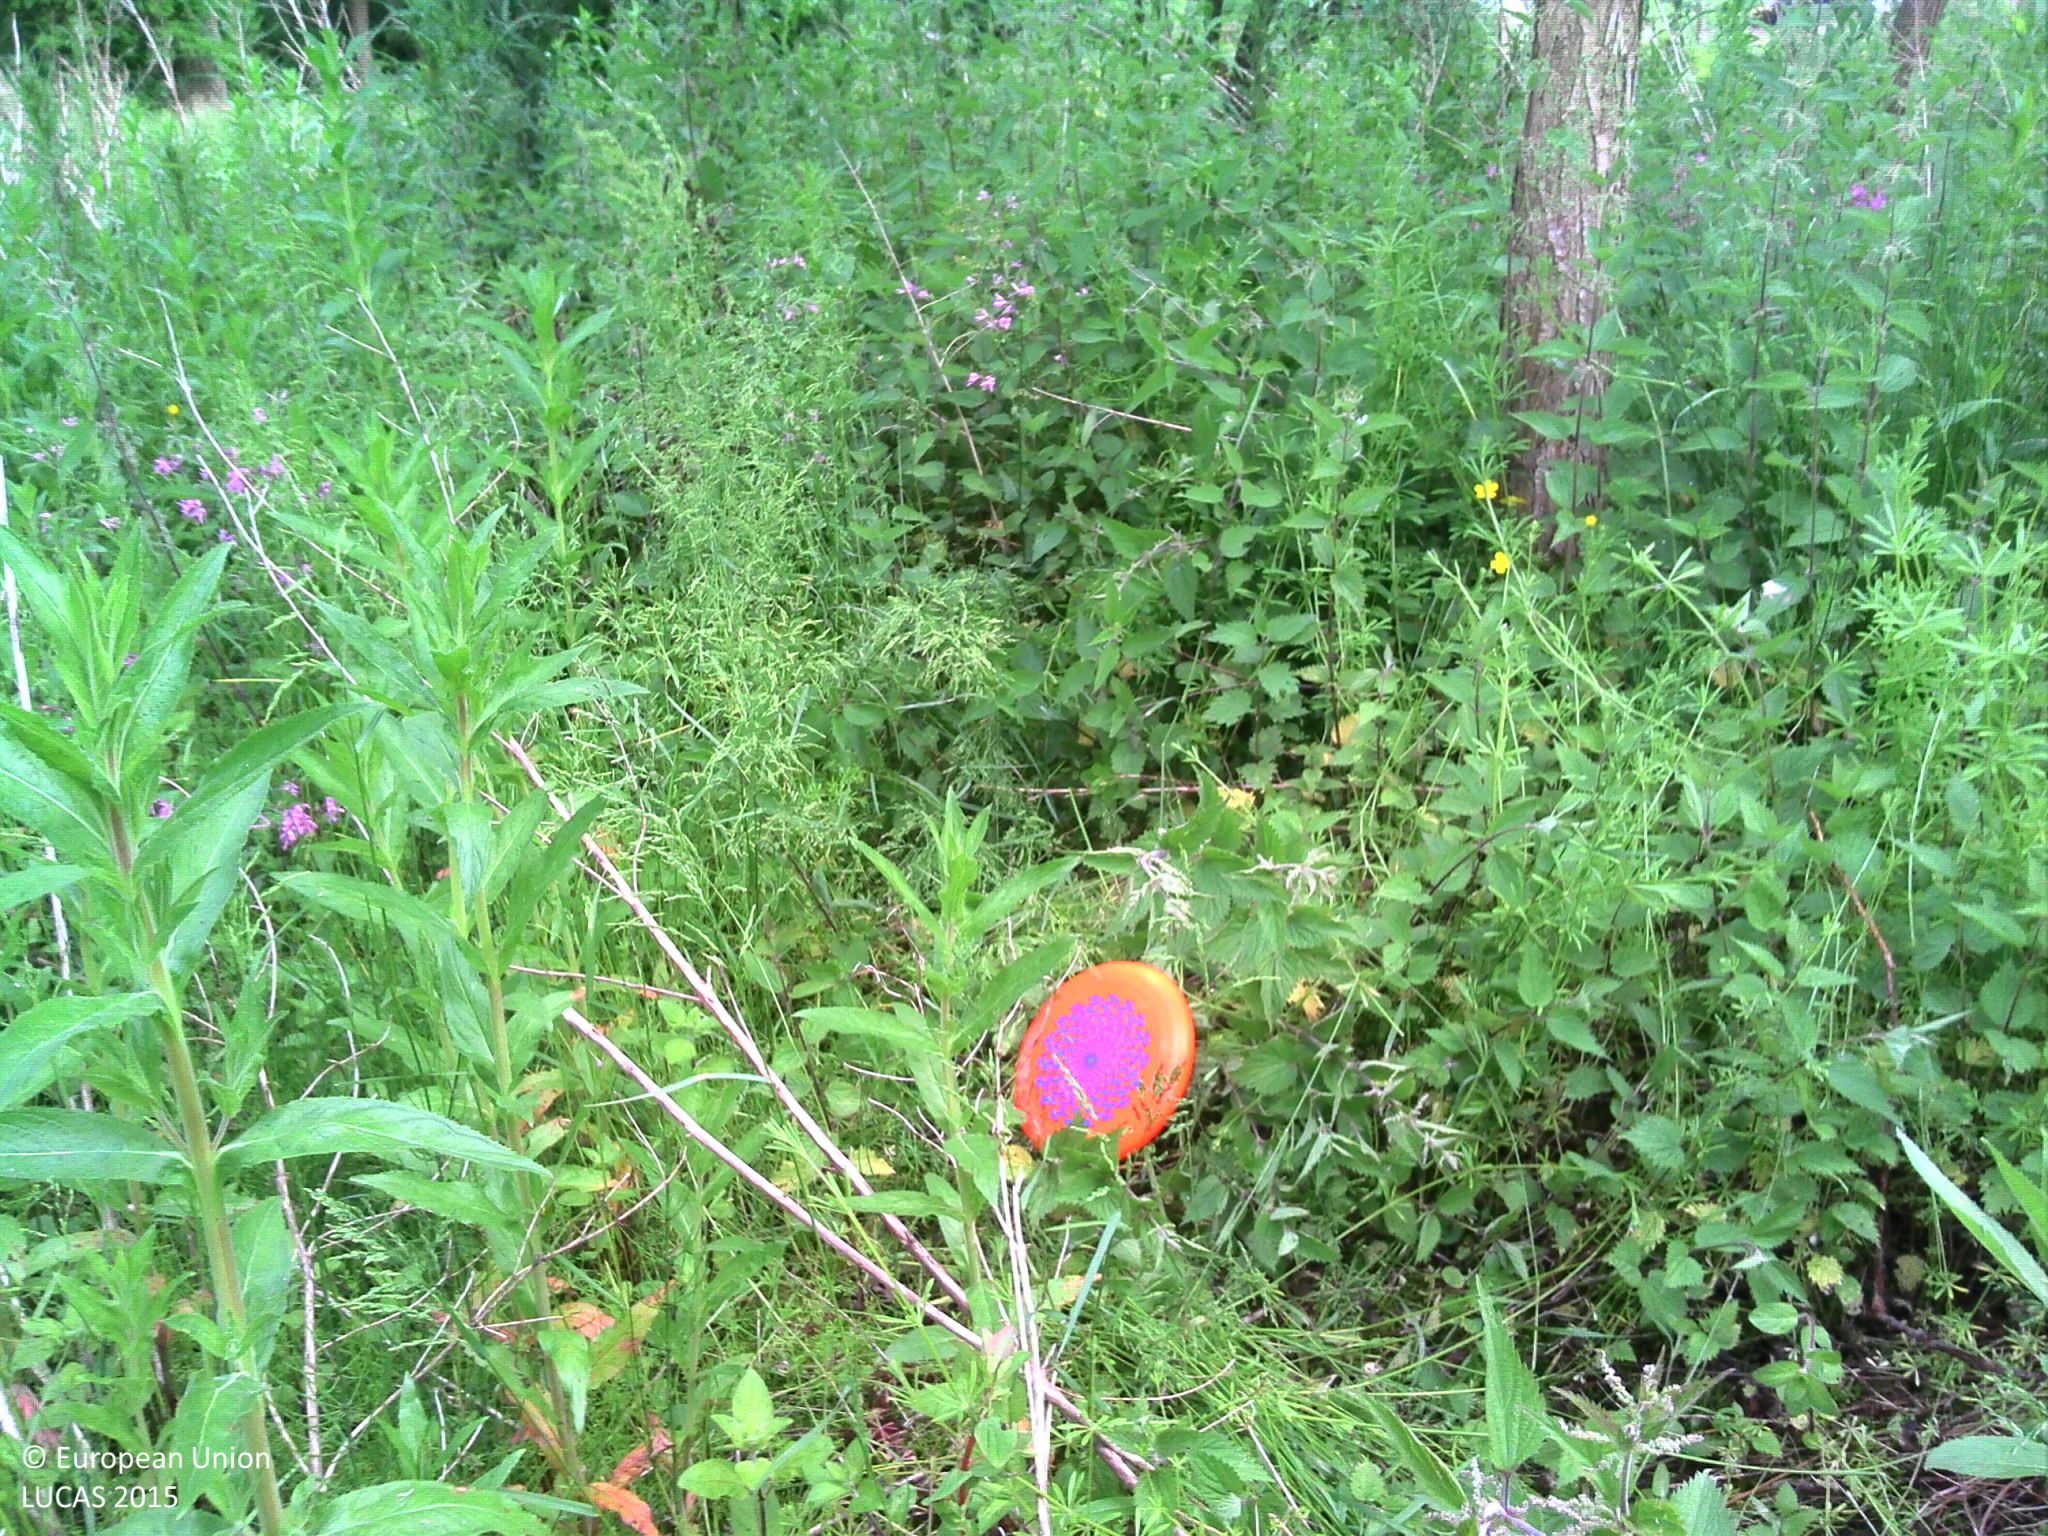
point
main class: Woodland
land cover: Broadleaved woodland
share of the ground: 50 - 75 %
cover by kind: broadleaved forest trees 60 %, herbaceous plants 40 %
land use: Forestry
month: June
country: BE
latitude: 50.7758
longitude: 3.8531
